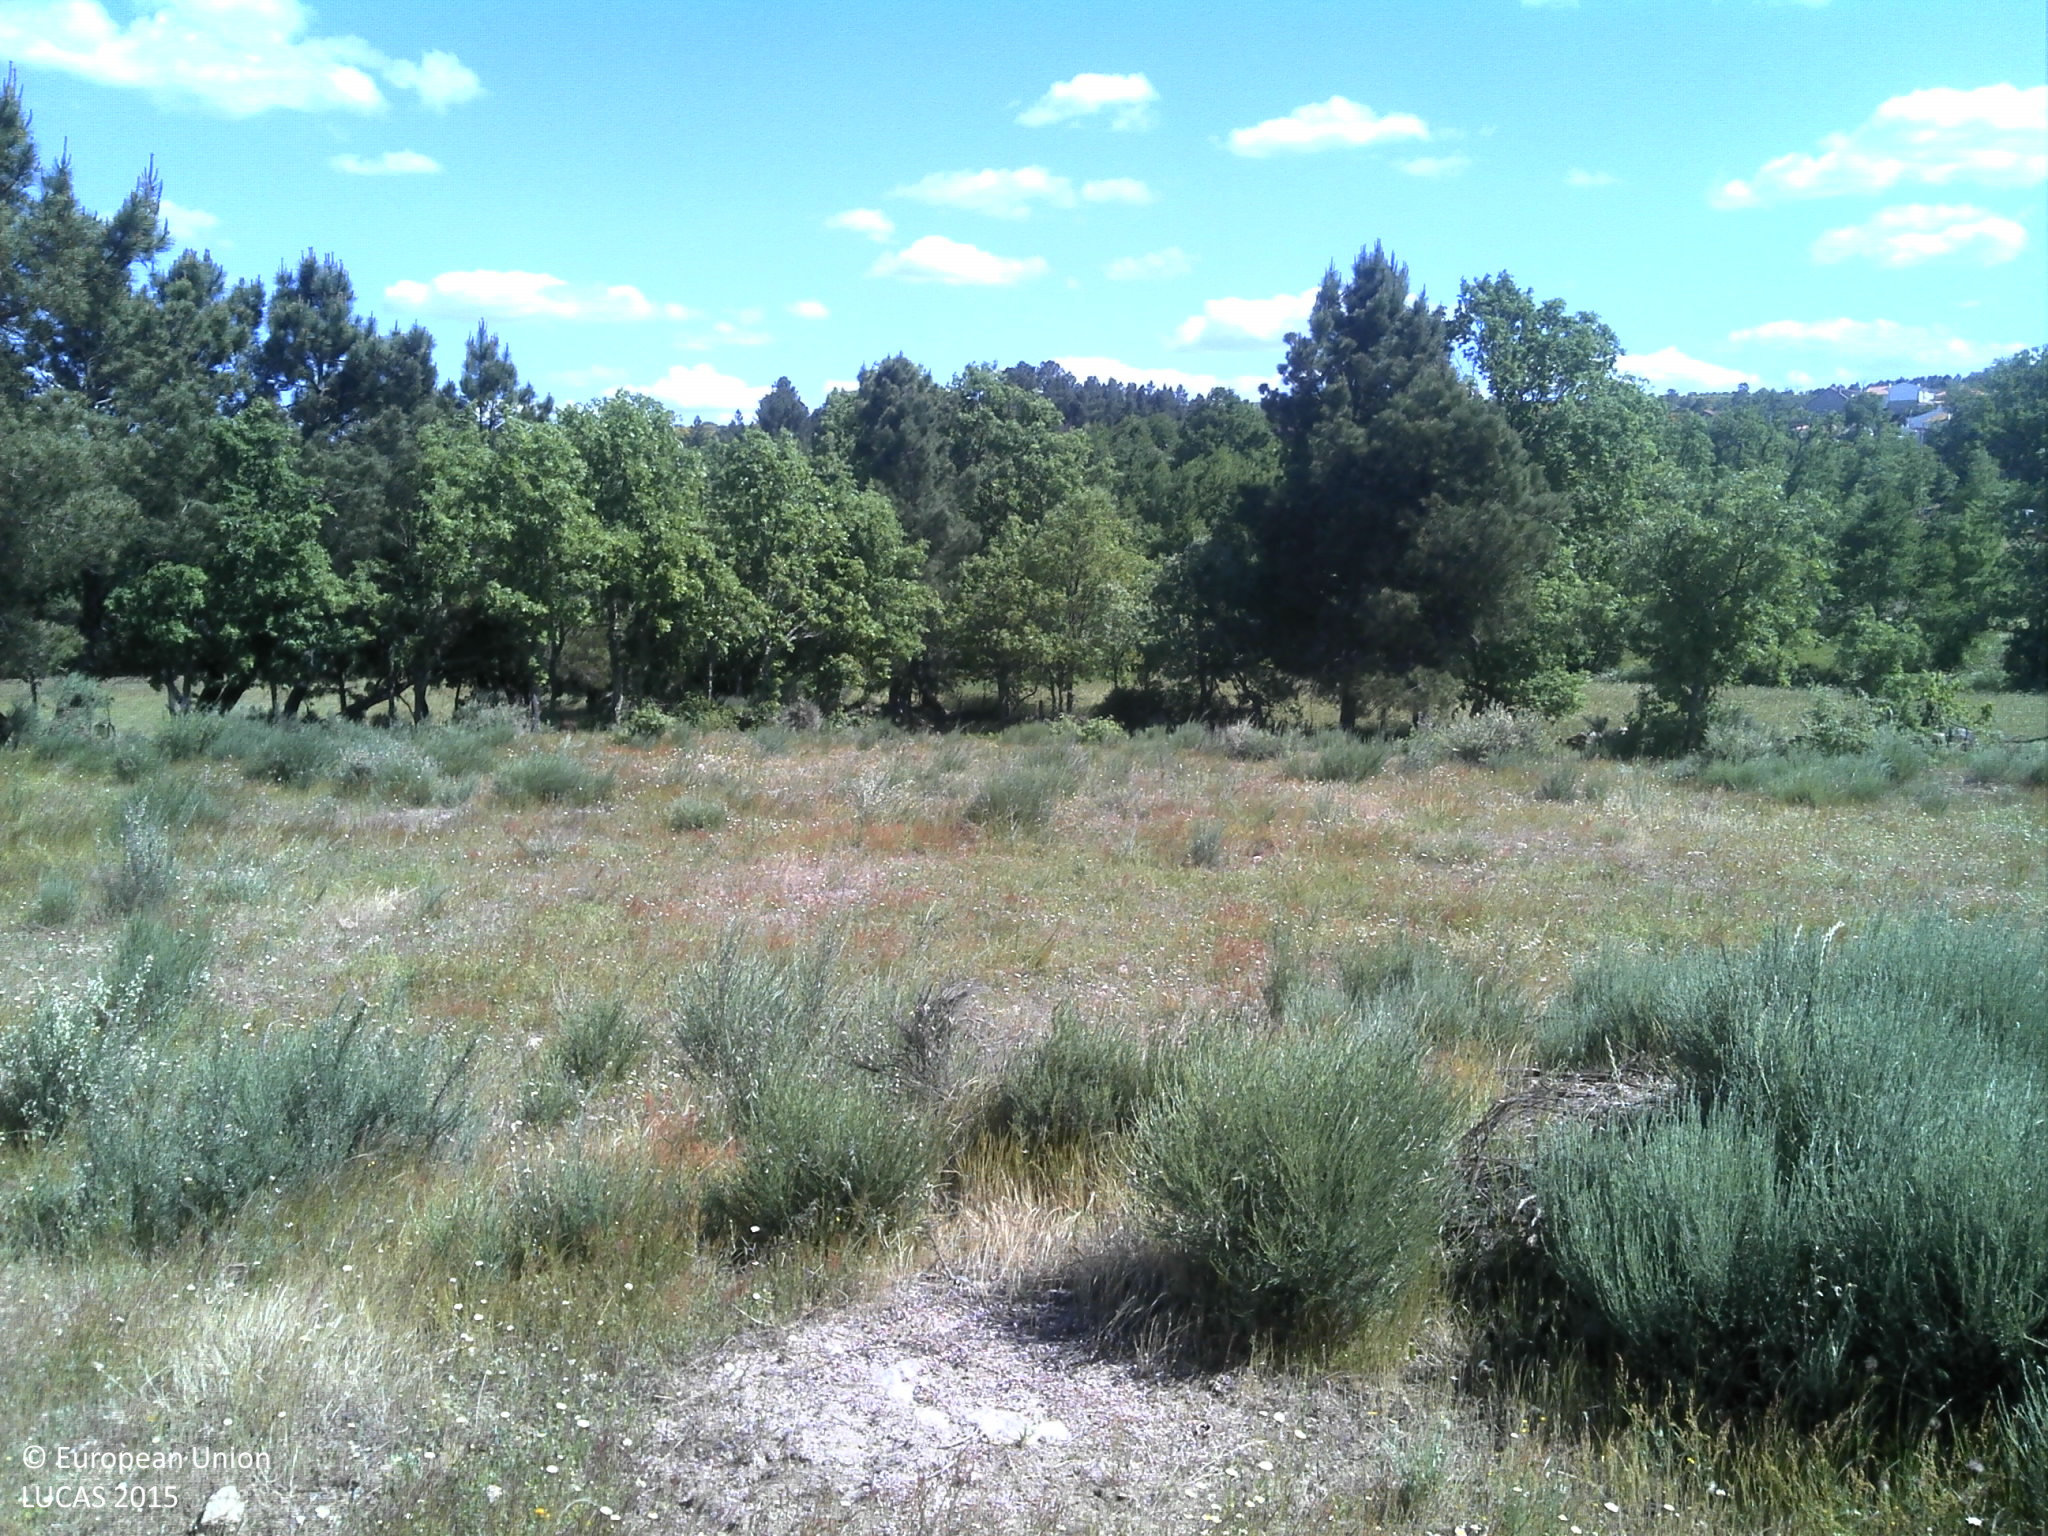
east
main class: Grassland
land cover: Grassland with sparse tree/shrub cover
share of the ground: 50 - 75 %
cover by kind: herbaceous plants 65 %, consolidated bare surface 20 %, broadleaved forest trees 5 %
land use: Agriculture (excluding fallow land and kitchen gardens)
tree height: < 5 m
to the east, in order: Grassland with sparse tree/shrub cover; Single bushes/trees; Grassland with sparse tree/shrub cover; Fences; Grass margins; Tracks; Fences; Grassland without tree/shrub cover; Pine dominated coniferous woodland
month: May
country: PT
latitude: 40.4879
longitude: -7.1982
